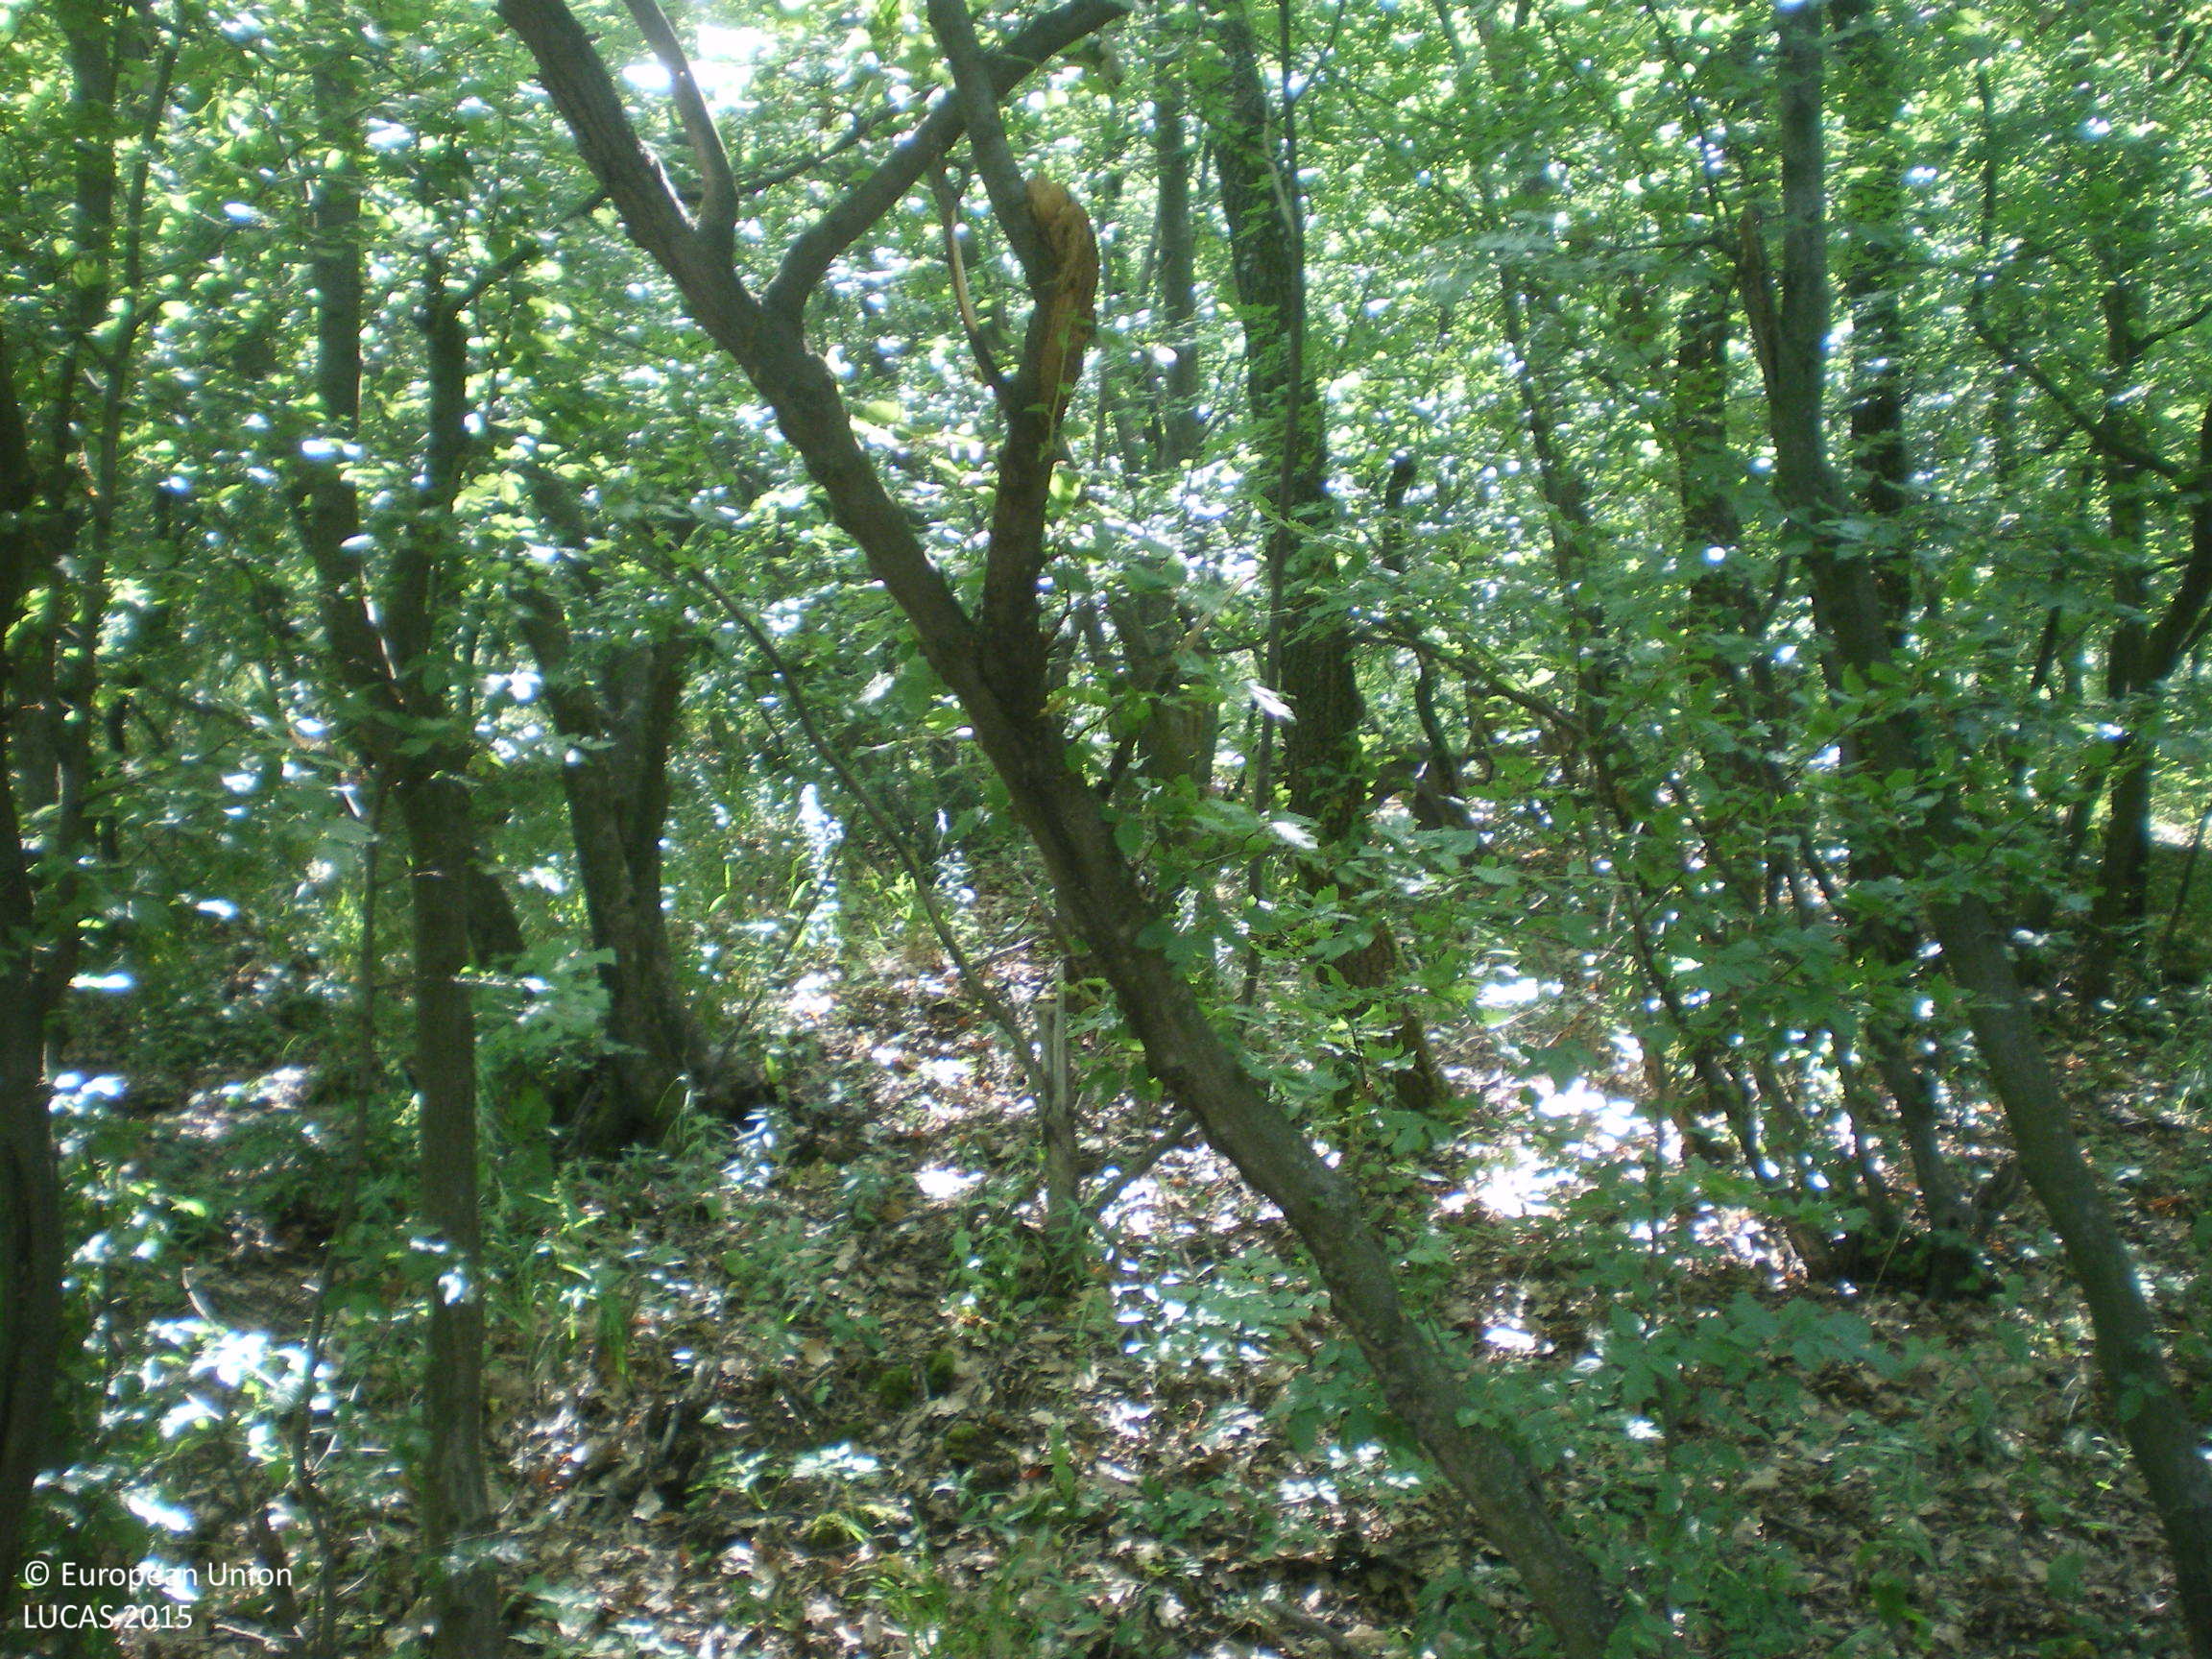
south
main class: Woodland
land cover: Broadleaved woodland
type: mesophytic deciduous forest
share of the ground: > 75 %
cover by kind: broadleaved forest trees 80 %, shrubs 15 %, herbaceous plants 5 %
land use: Forestry
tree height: > 5 m
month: June
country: BG
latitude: 42.3976
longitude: 25.5597
